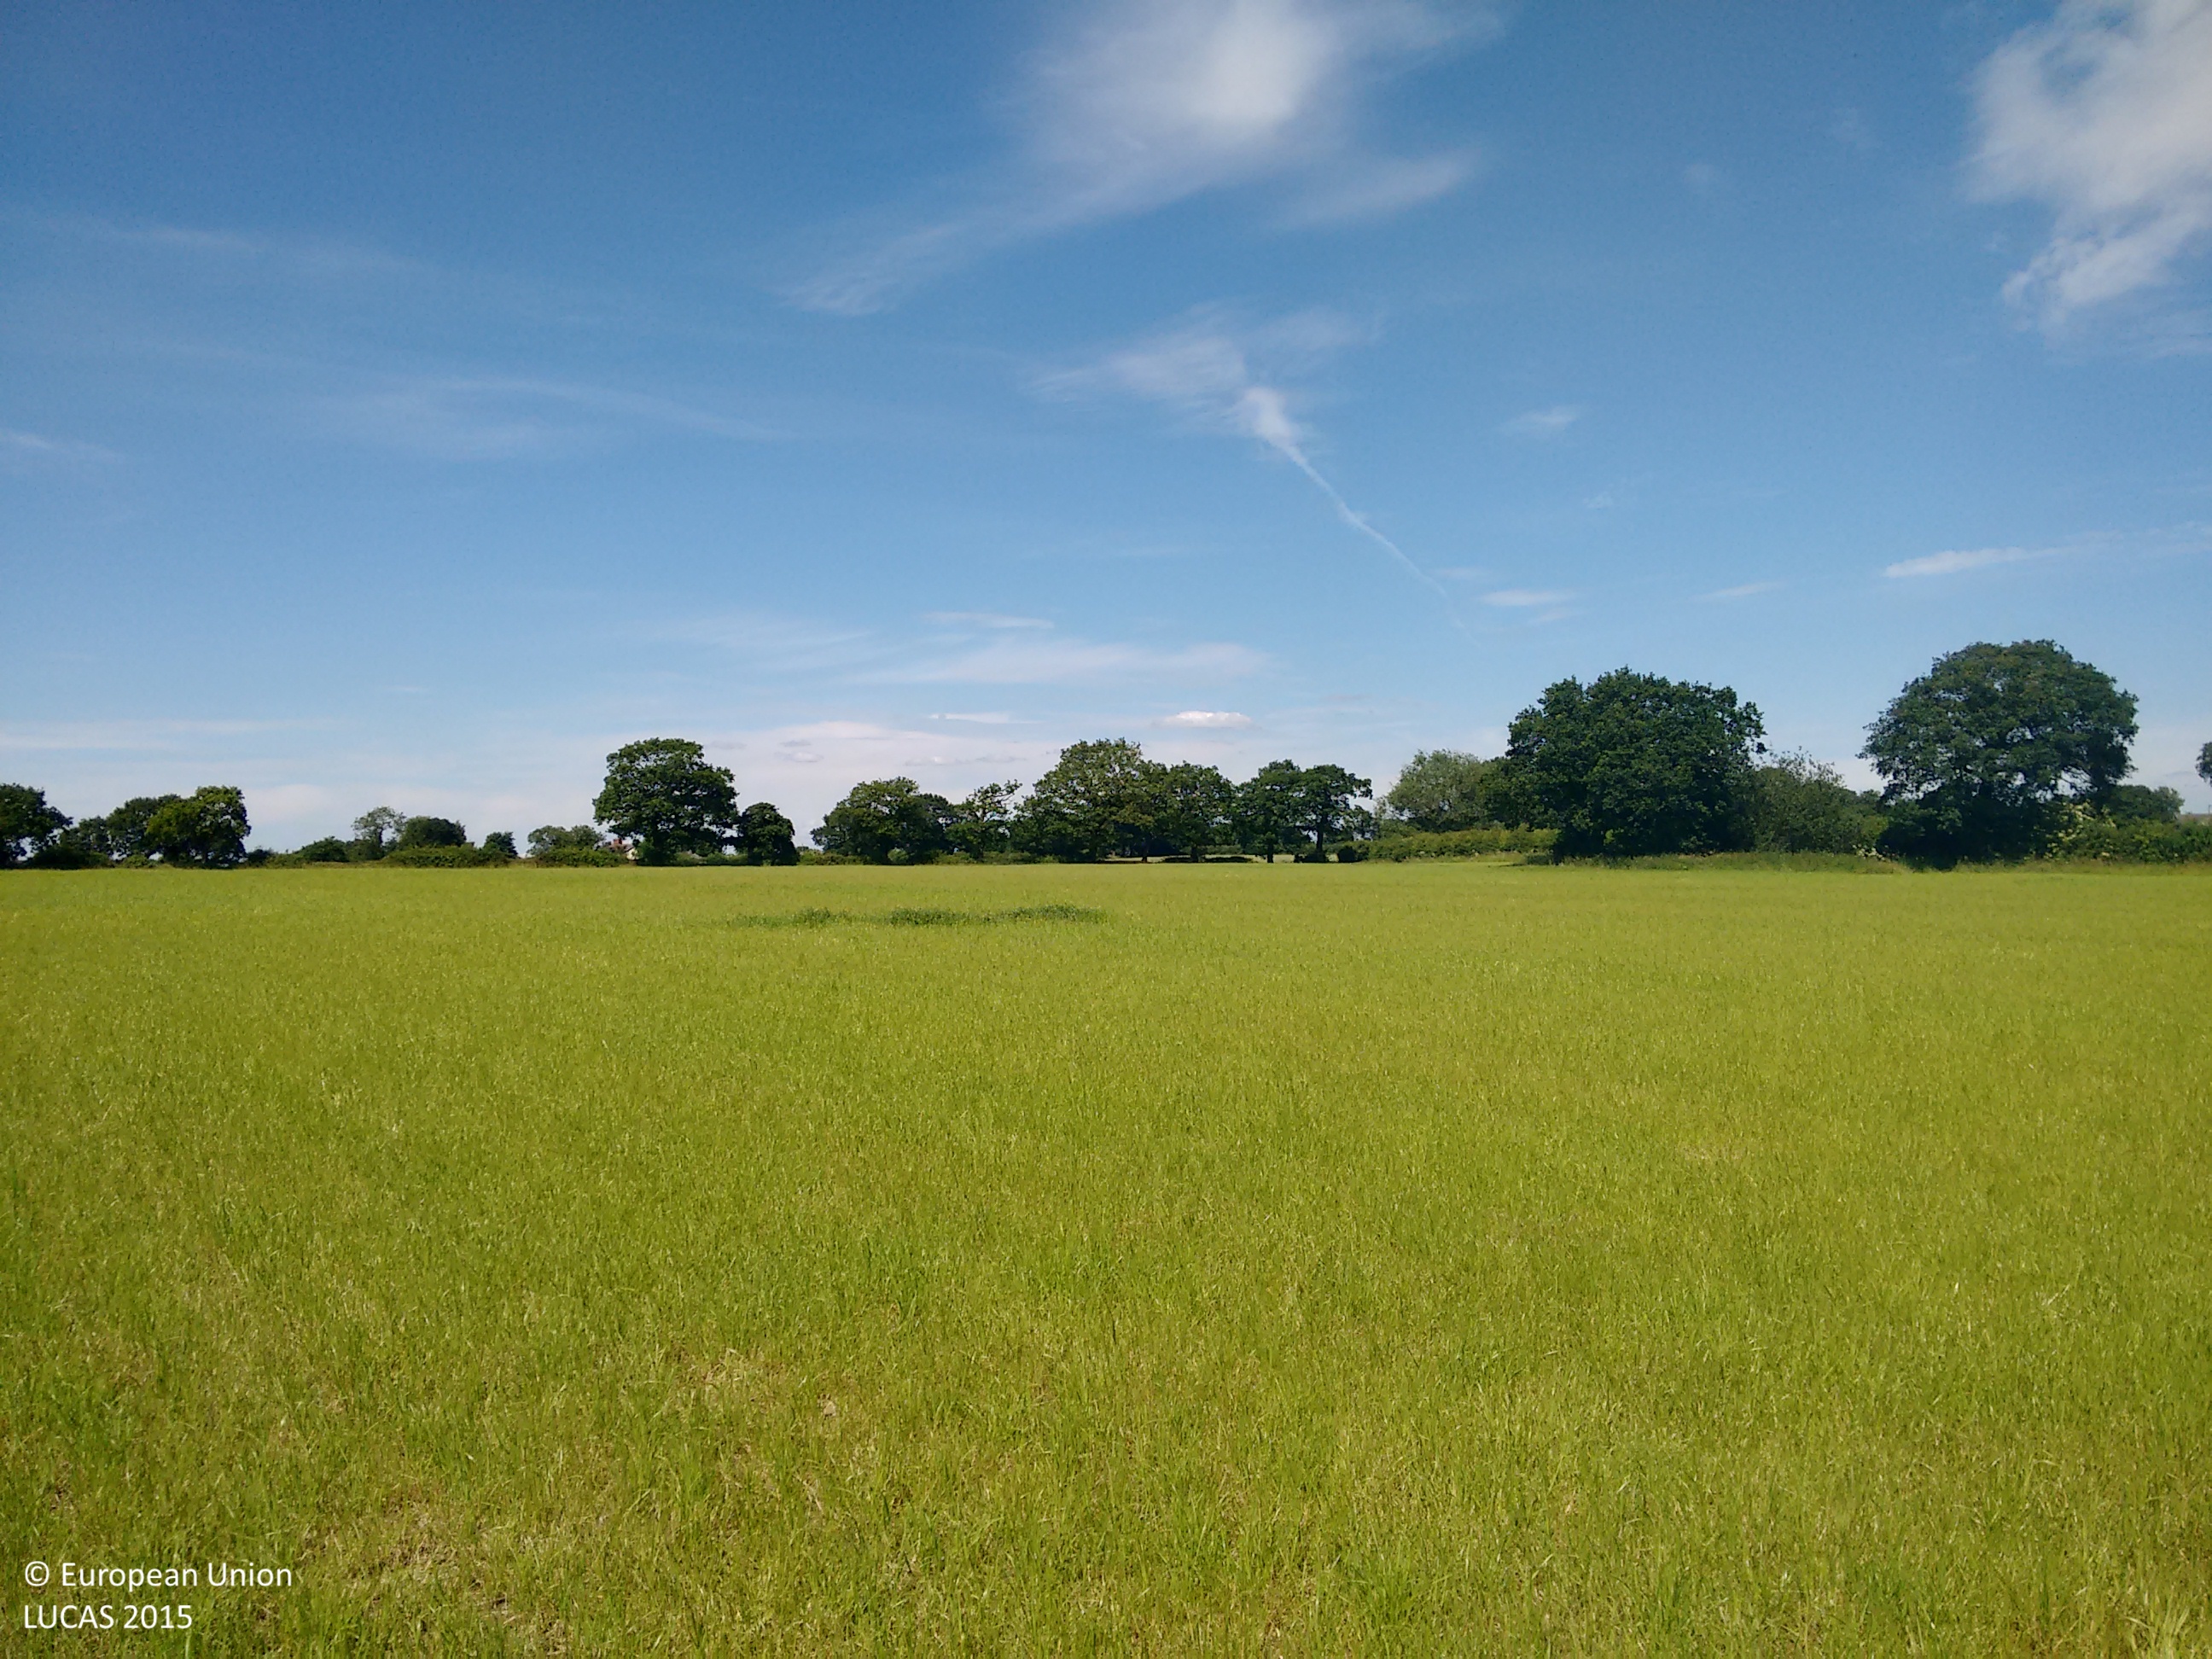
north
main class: Cropland
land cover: Temporary grasslands
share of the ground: > 75 %
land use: Agriculture (excluding fallow land and kitchen gardens)
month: July
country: GB
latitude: 53.3321
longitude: -2.5143
